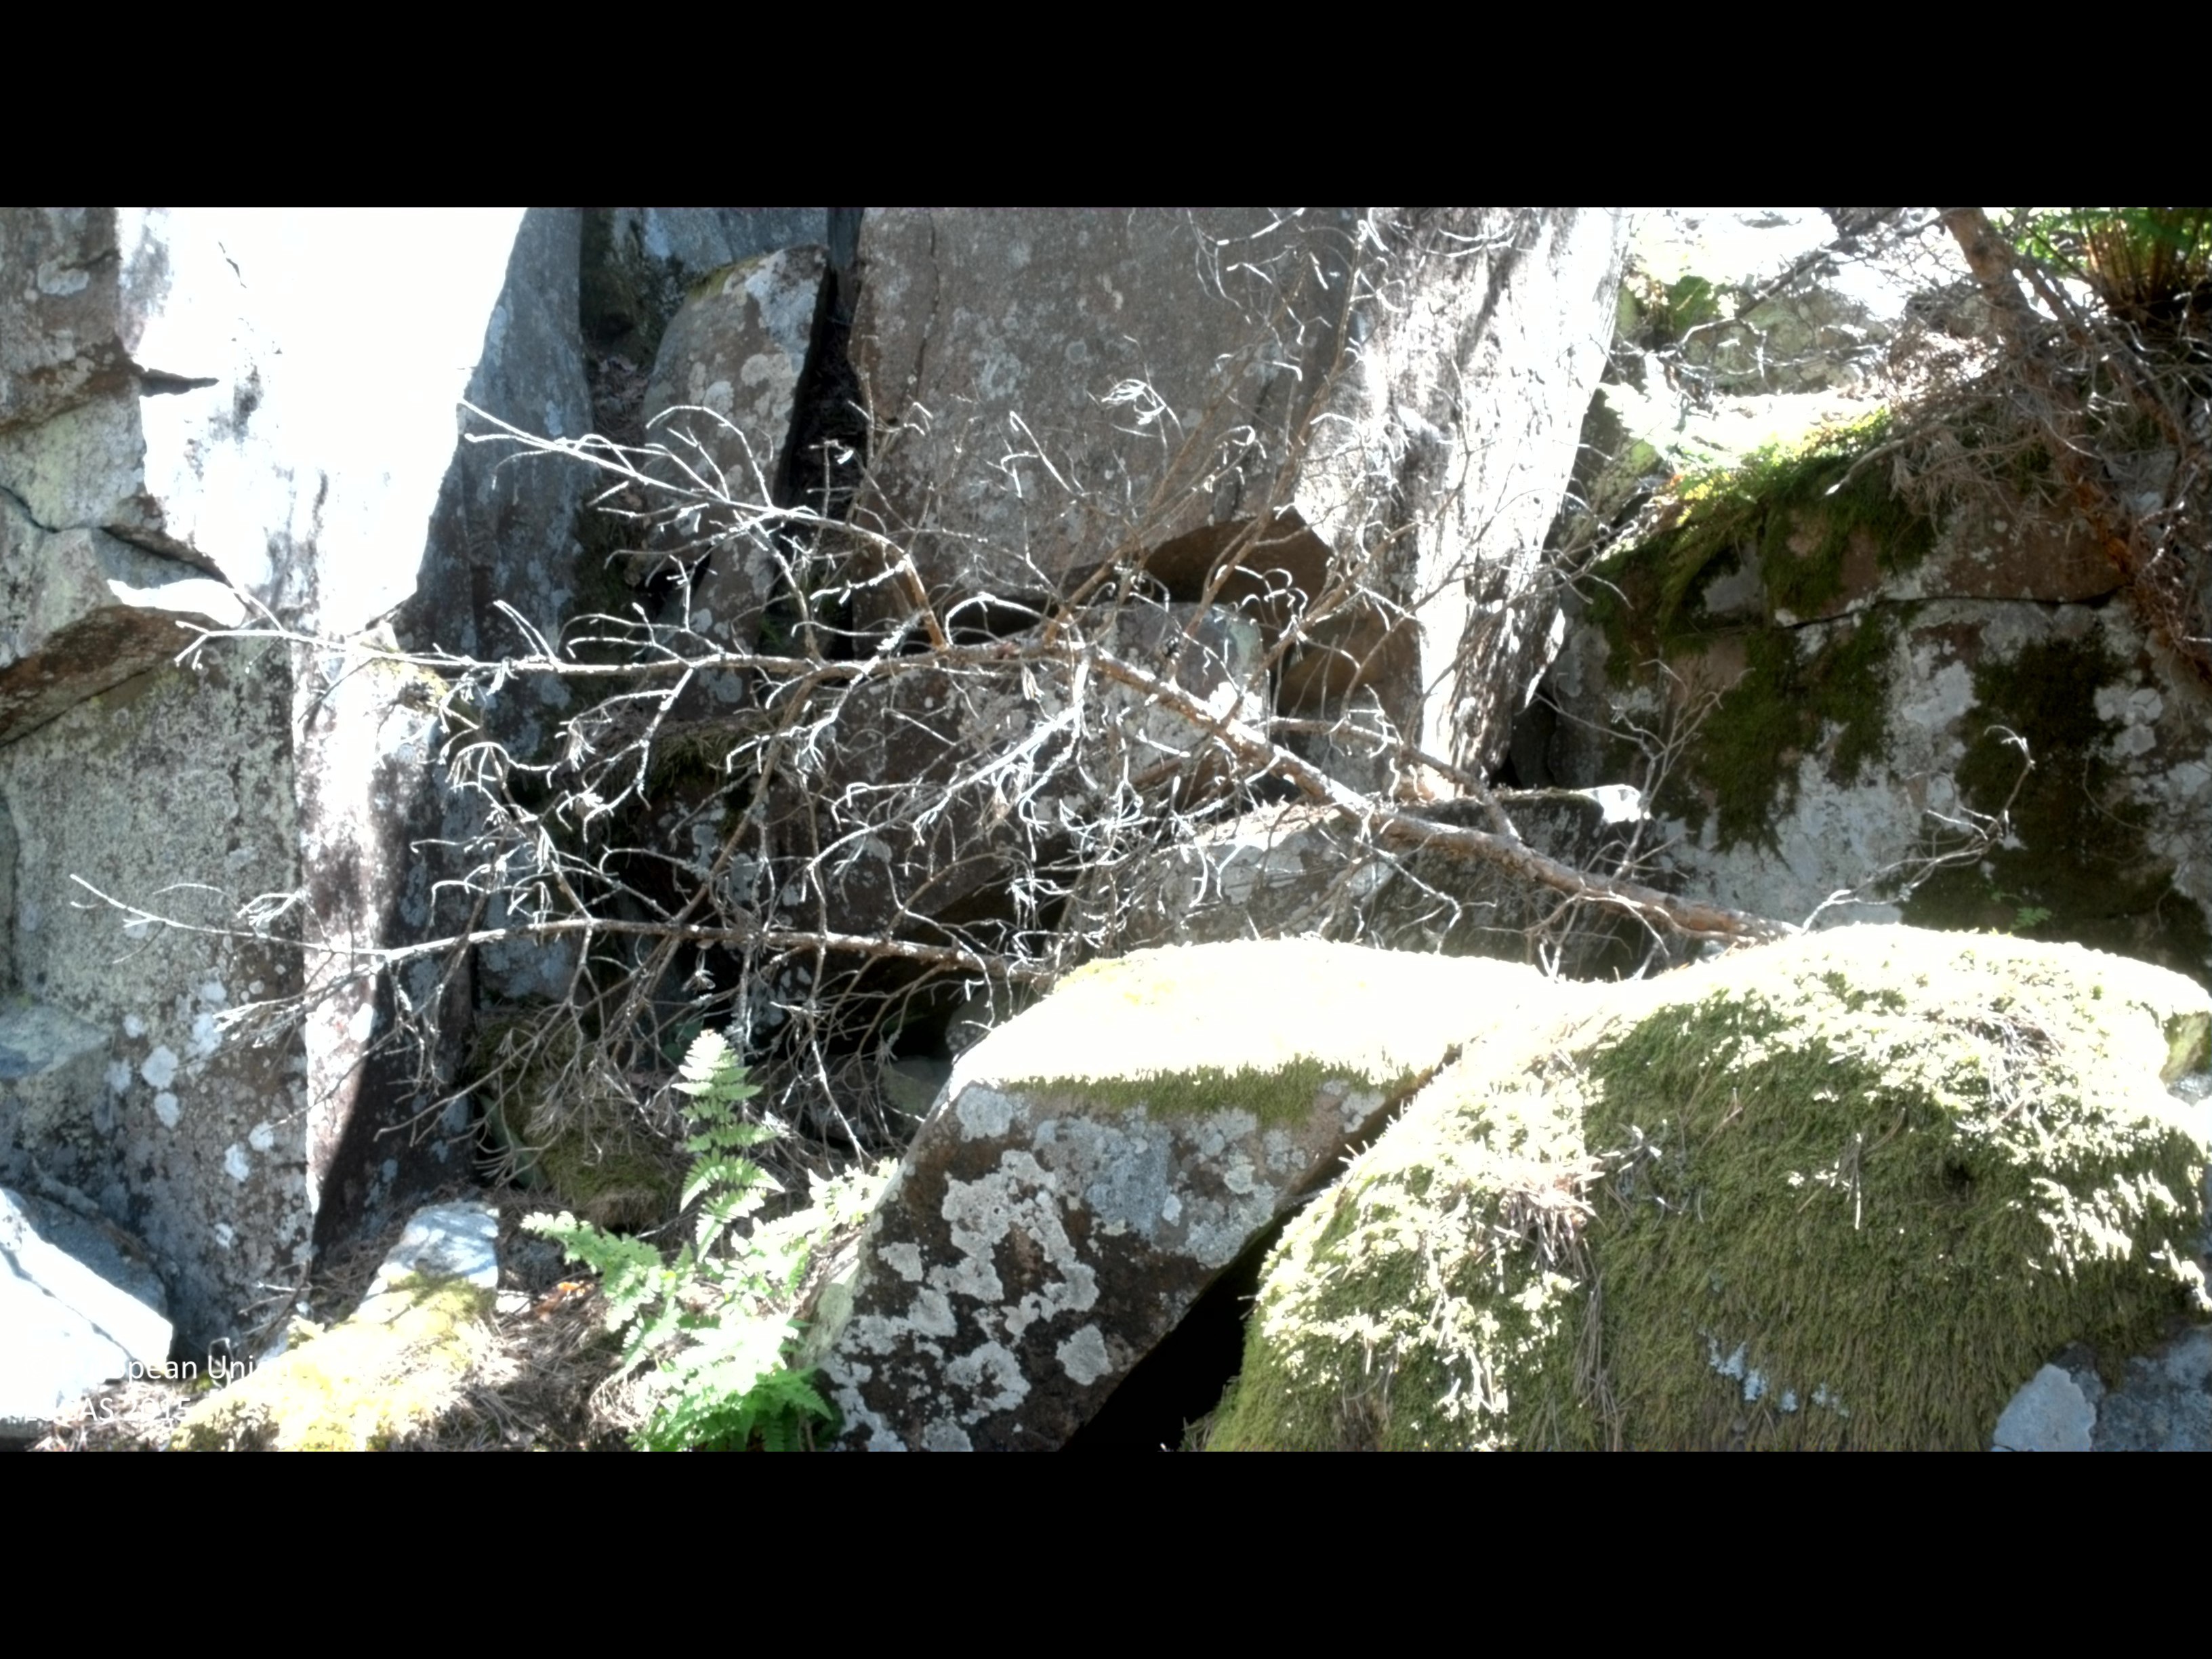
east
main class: Woodland
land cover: Pine dominated coniferous woodland
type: hemiboreal forest and nemoral coniferous forest and mixed broadleaved-coniferous forest
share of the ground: 50 - 75 %
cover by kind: coniferous forest trees 55 %, broadleaved forest trees 15 %, consolidated bare surface 15 %, lichens and mosses 10 %, shrubs 5 %
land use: Forestry
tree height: > 5 m
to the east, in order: Pine dominated coniferous woodland; Rocks and stones; Pine dominated coniferous woodland; Spruce dominated coniferous woodland
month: June
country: SE
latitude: 57.6950
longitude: 16.6258
